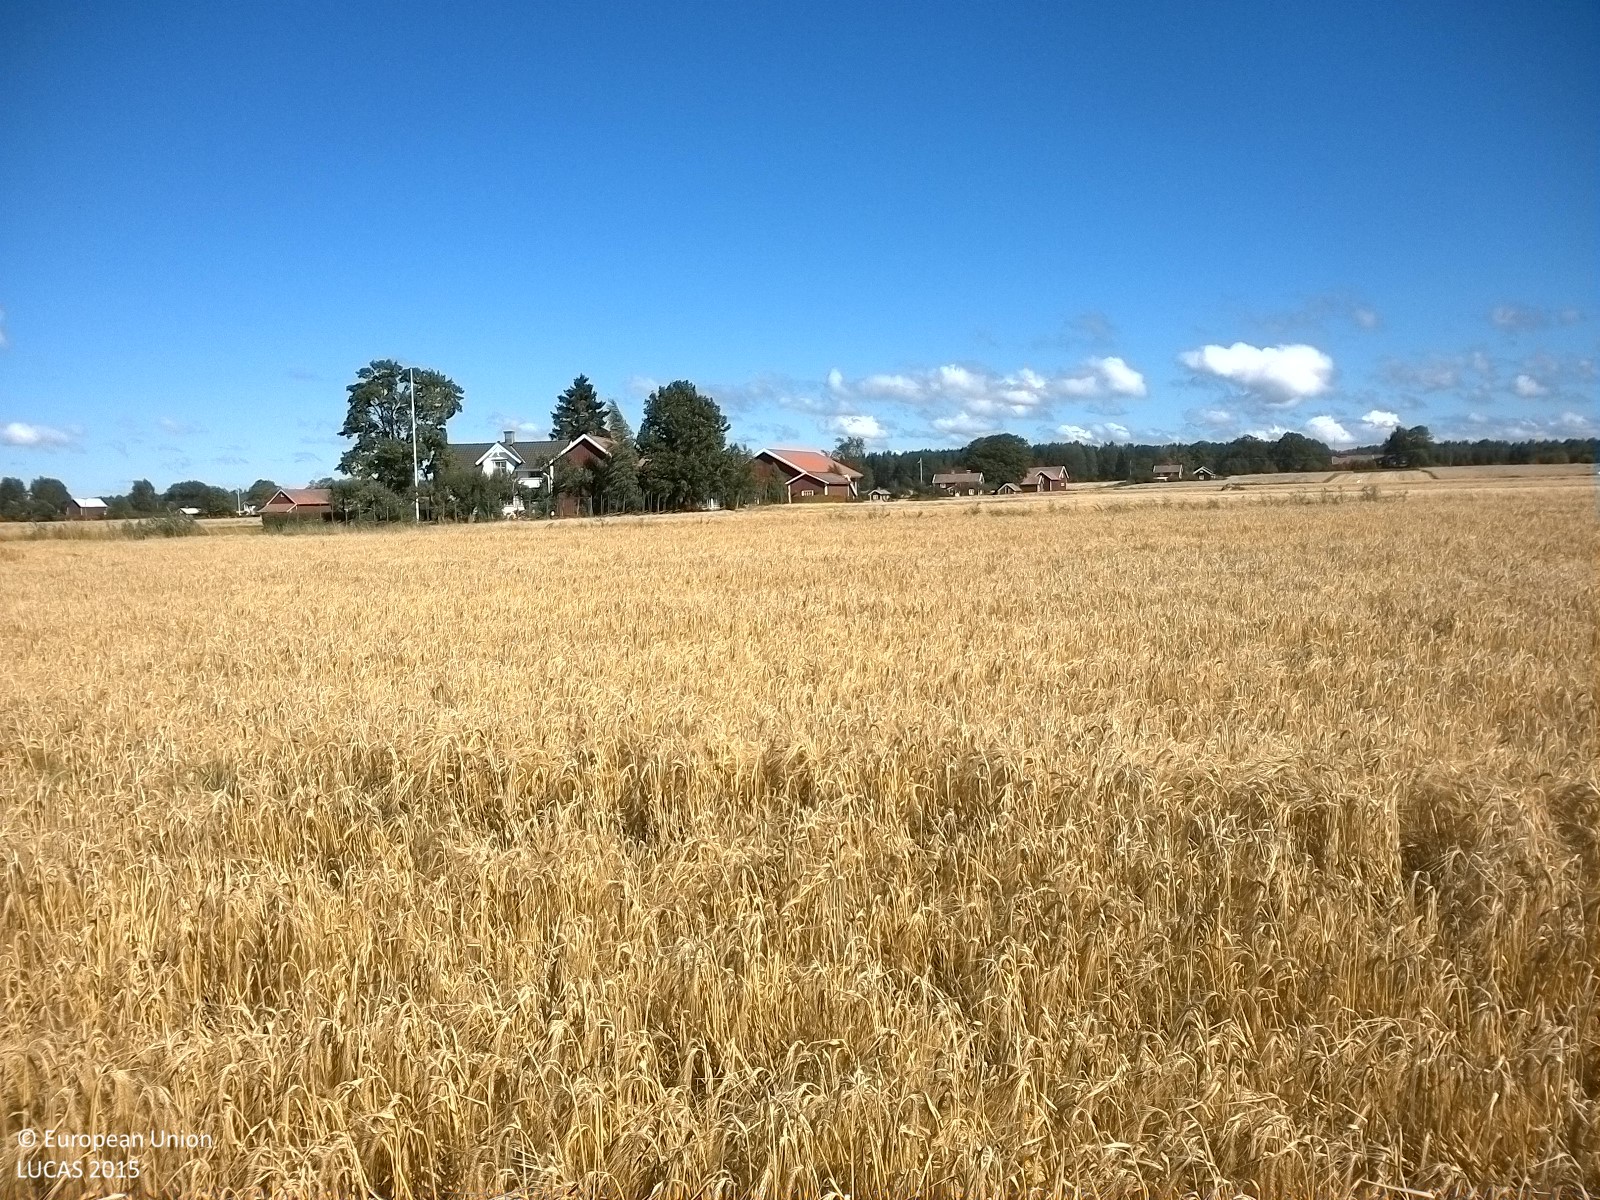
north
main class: Cropland
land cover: Barley
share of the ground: > 75 %
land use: Agriculture (excluding fallow land and kitchen gardens)
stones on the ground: < 10 %
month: August
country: SE
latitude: 59.2055
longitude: 15.5434
